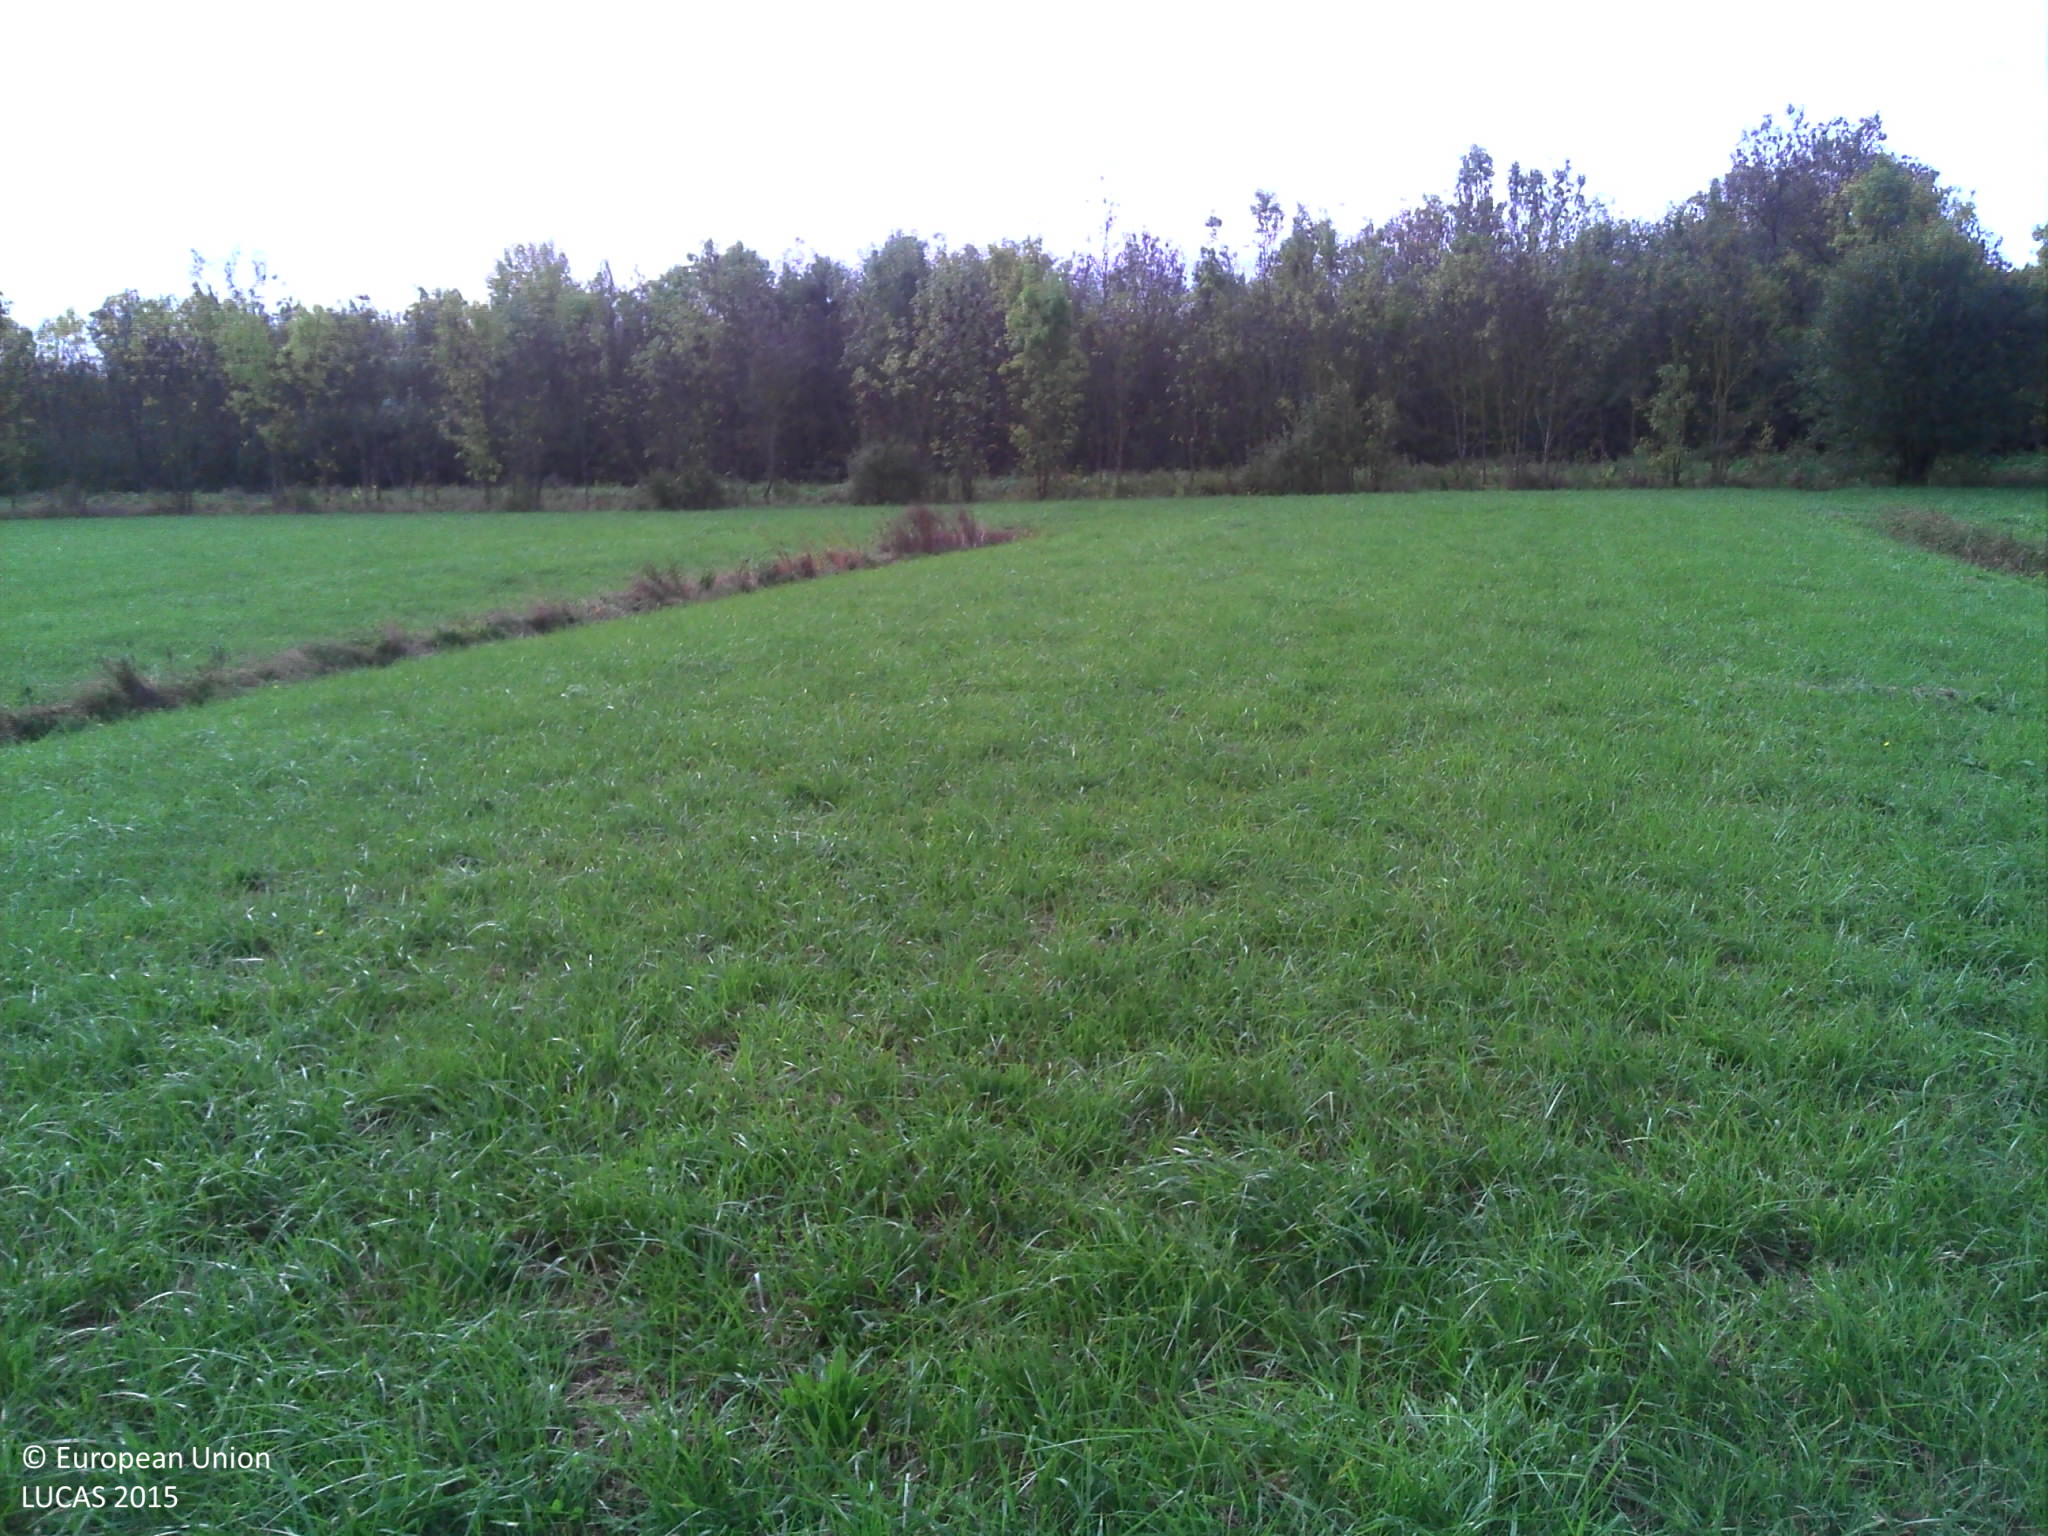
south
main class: Grassland
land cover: Grassland without tree/shrub cover
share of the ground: > 75 %
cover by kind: herbaceous plants 100 %
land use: Agriculture (excluding fallow land and kitchen gardens)
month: October
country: FR
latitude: 46.4483
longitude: -1.0585
